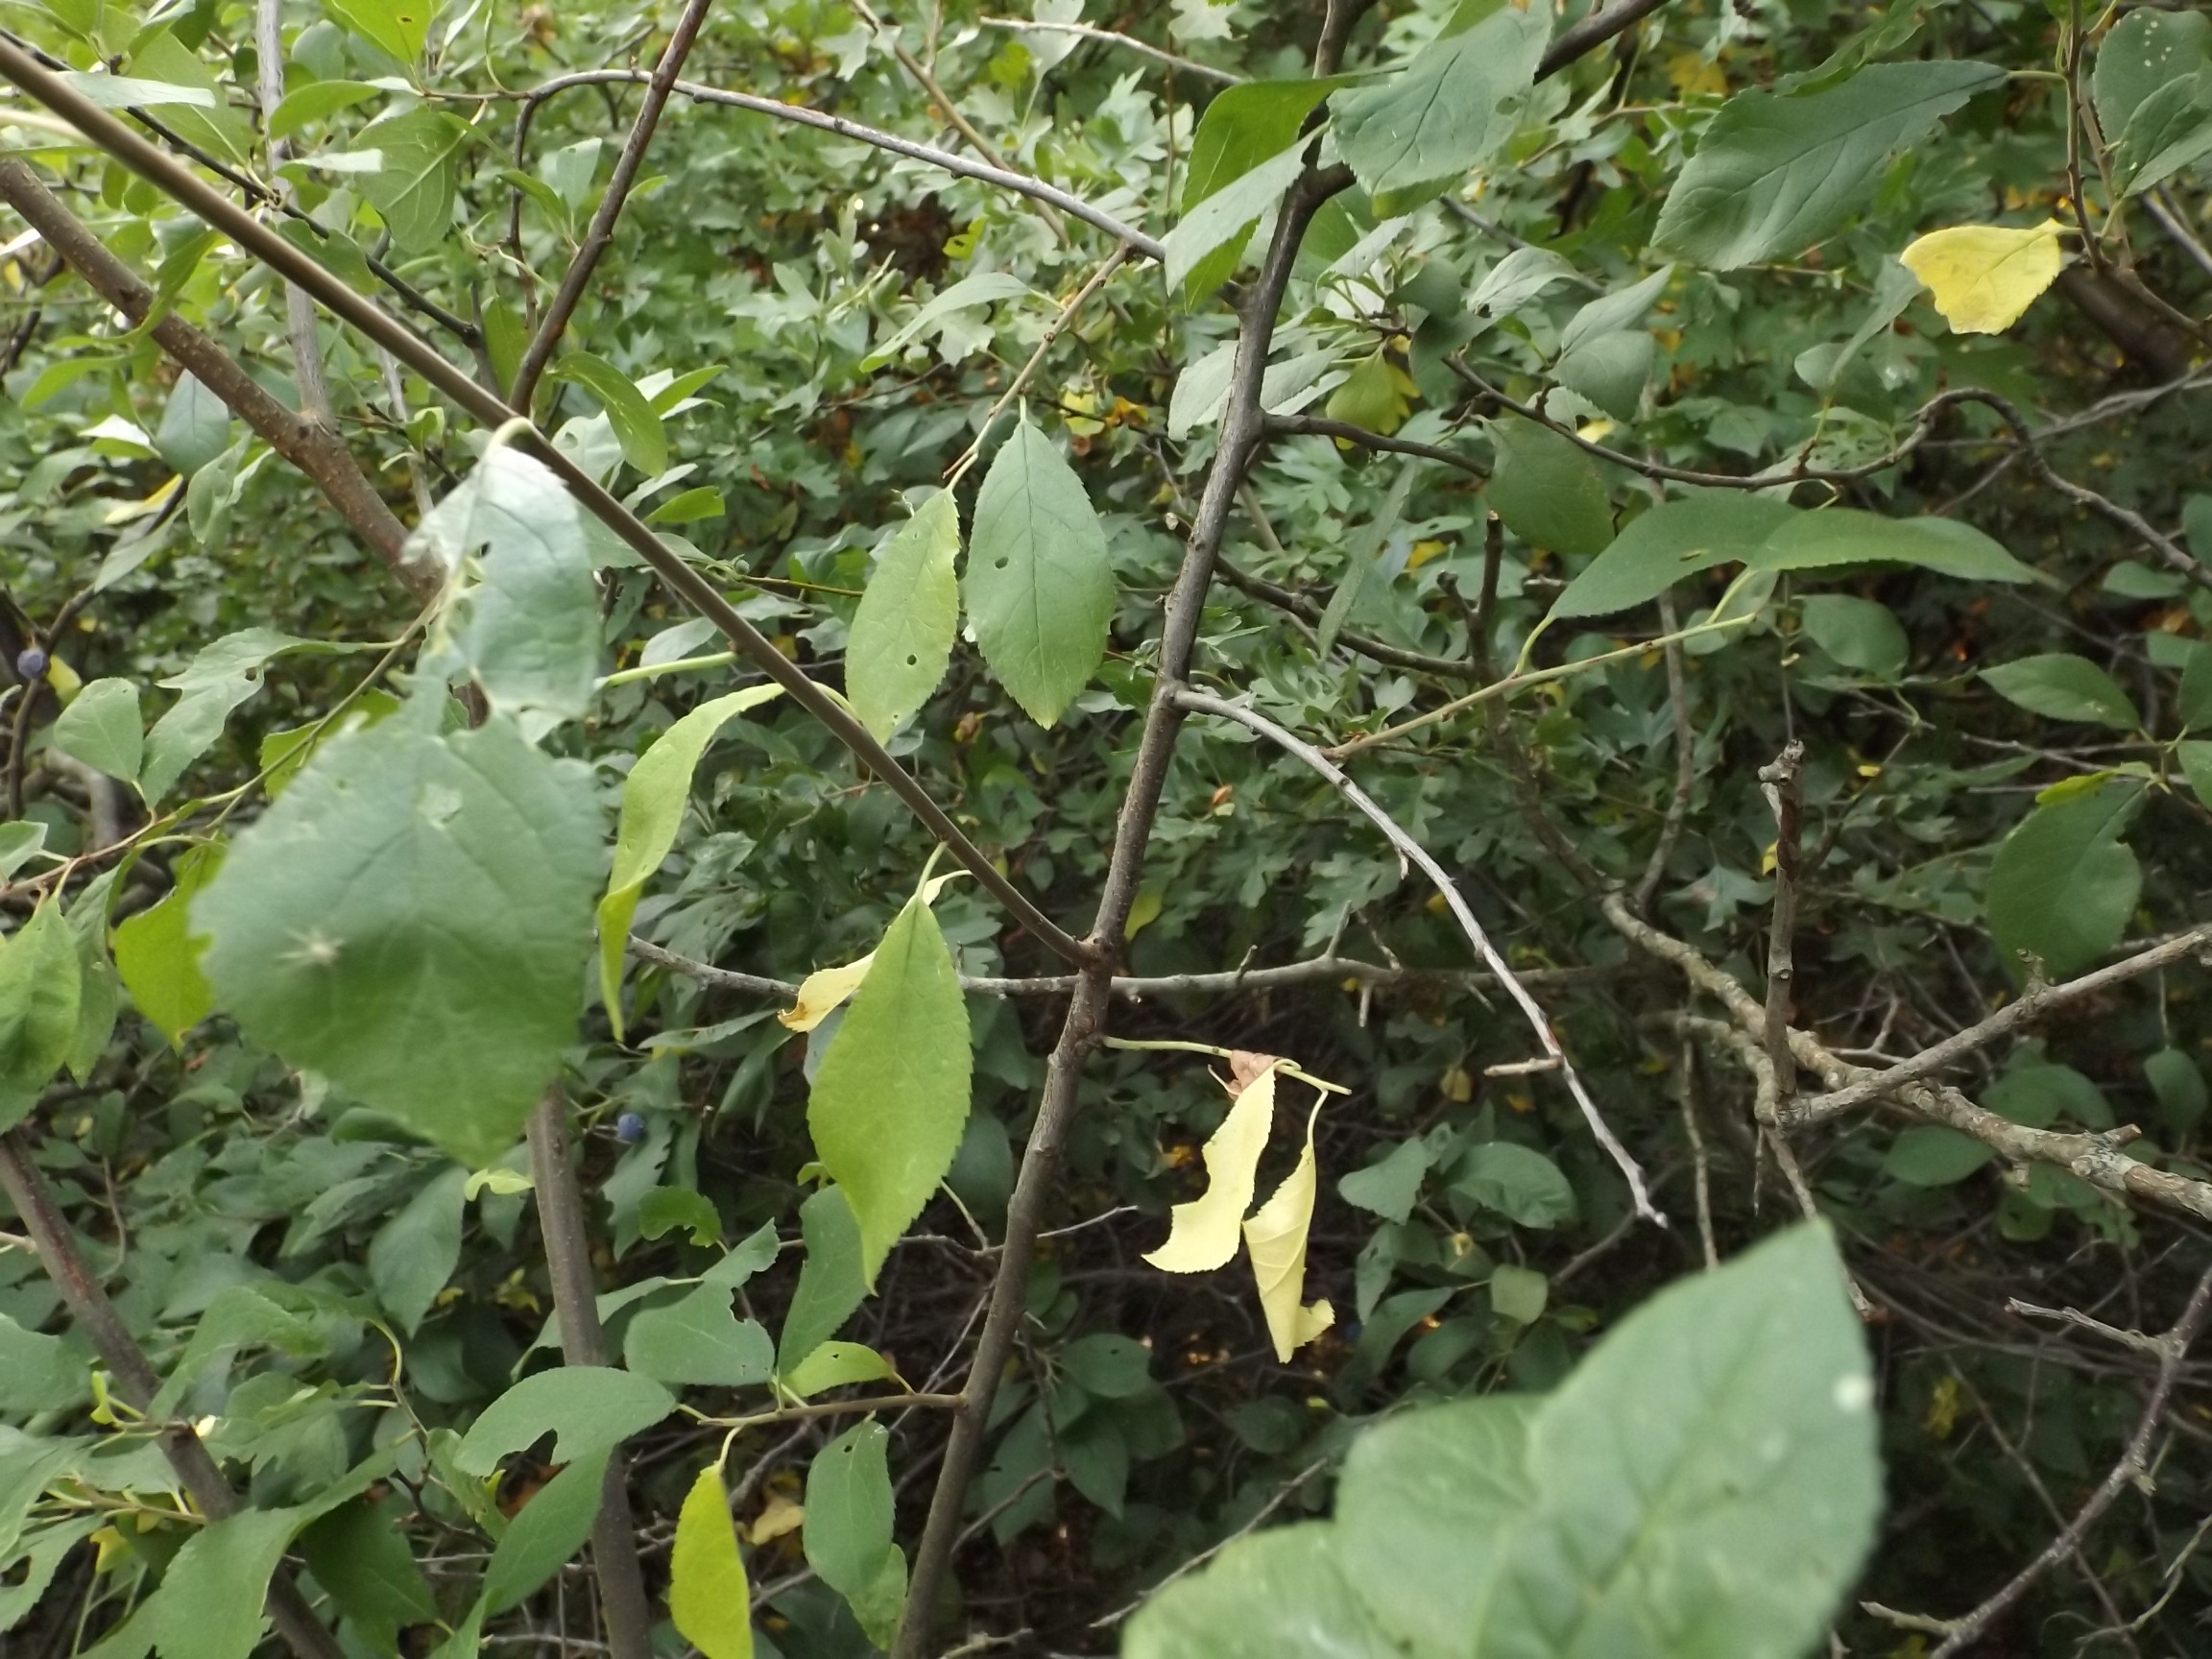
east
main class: Woodland
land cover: Broadleaved woodland
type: beech forest
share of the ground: 50 - 75 %
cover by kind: broadleaved forest trees 70 %, shrubs 20 %, herbaceous plants 10 %
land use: Forestry
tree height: > 5 m
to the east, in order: Broadleaved woodland
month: July
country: BG
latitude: 43.4721
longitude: 27.6262
